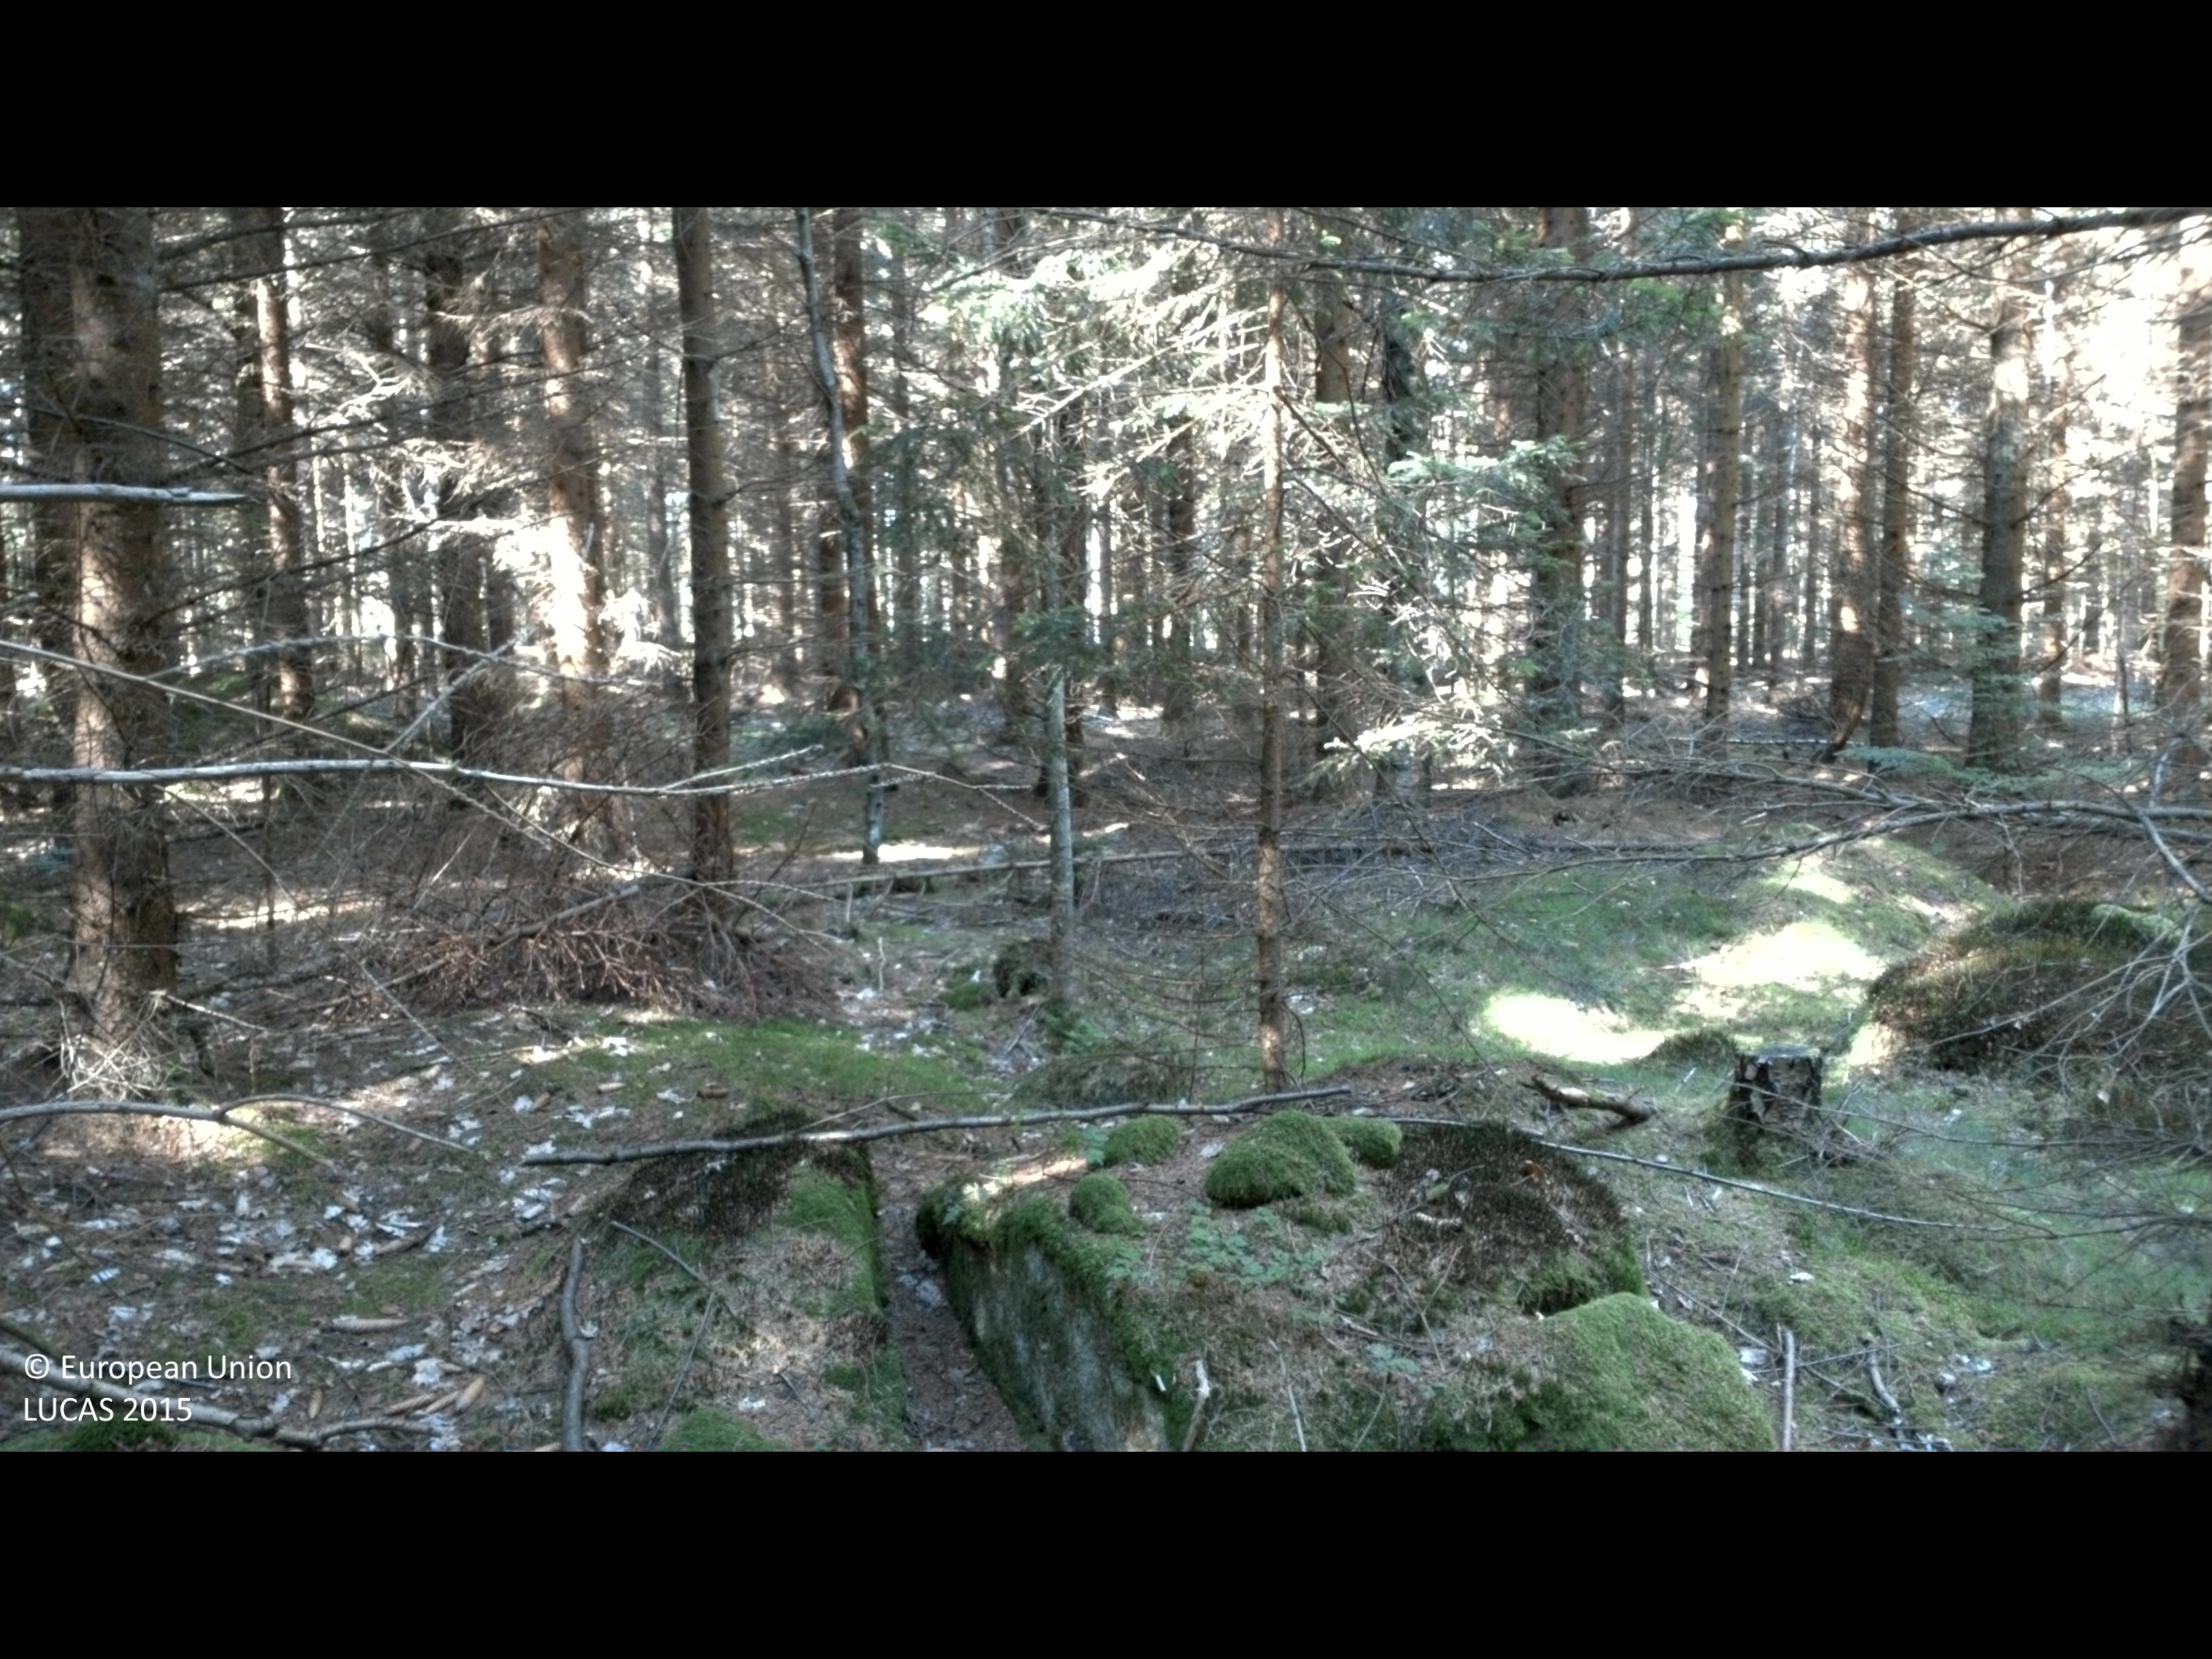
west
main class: Woodland
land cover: Spruce dominated coniferous woodland
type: boreal forest
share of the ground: > 75 %
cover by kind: coniferous forest trees 75 %, lichens and mosses 10 %, broadleaved forest trees 5 %, shrubs 5 %, herbaceous plants 5 %
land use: Forestry
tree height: > 5 m
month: August
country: SE
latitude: 56.2508
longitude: 15.8914
